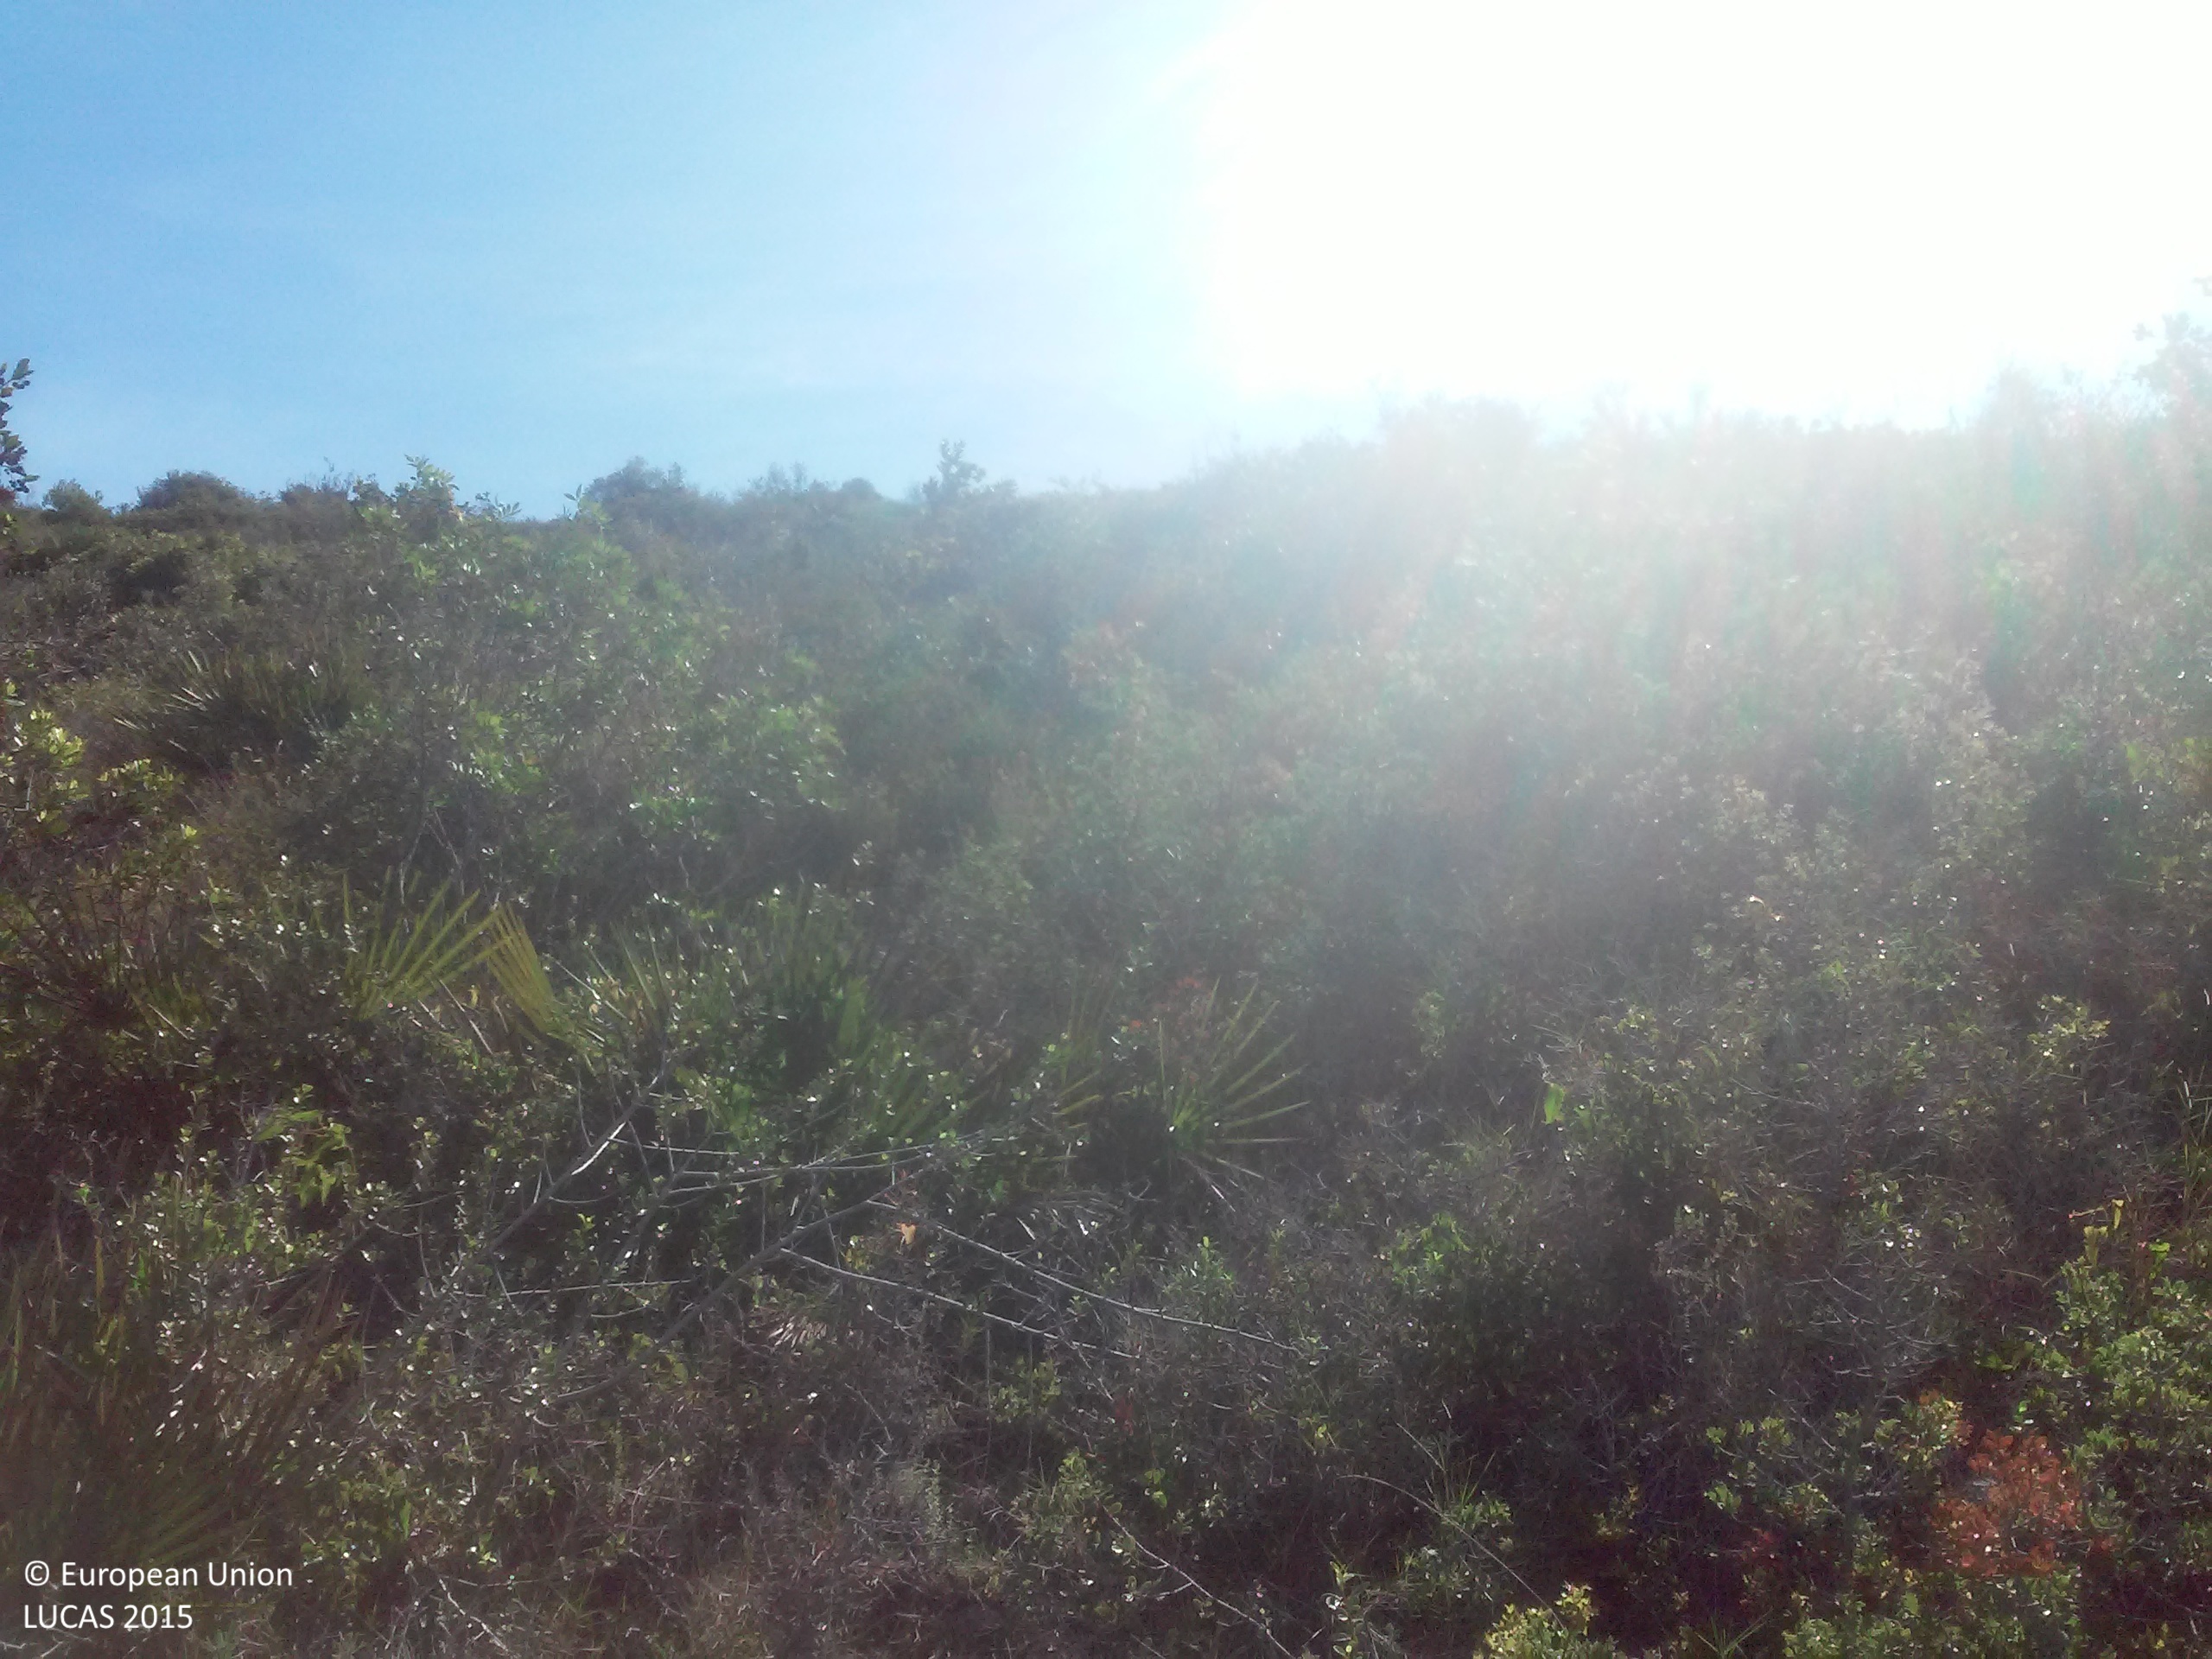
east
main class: Shrubland
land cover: Shrubland with sparse tree cover
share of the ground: 25 - 50 %
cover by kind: shrubs 75 %, herbaceous plants 20 %, broadleaved forest trees 5 %
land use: Semi-natural and natural areas not in use
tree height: < 5 m
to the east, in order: Shrubland with sparse tree cover; Tracks; Shrubland with sparse tree cover; Pine dominated coniferous woodland
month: September
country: ES
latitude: 41.2160
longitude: 1.6092
